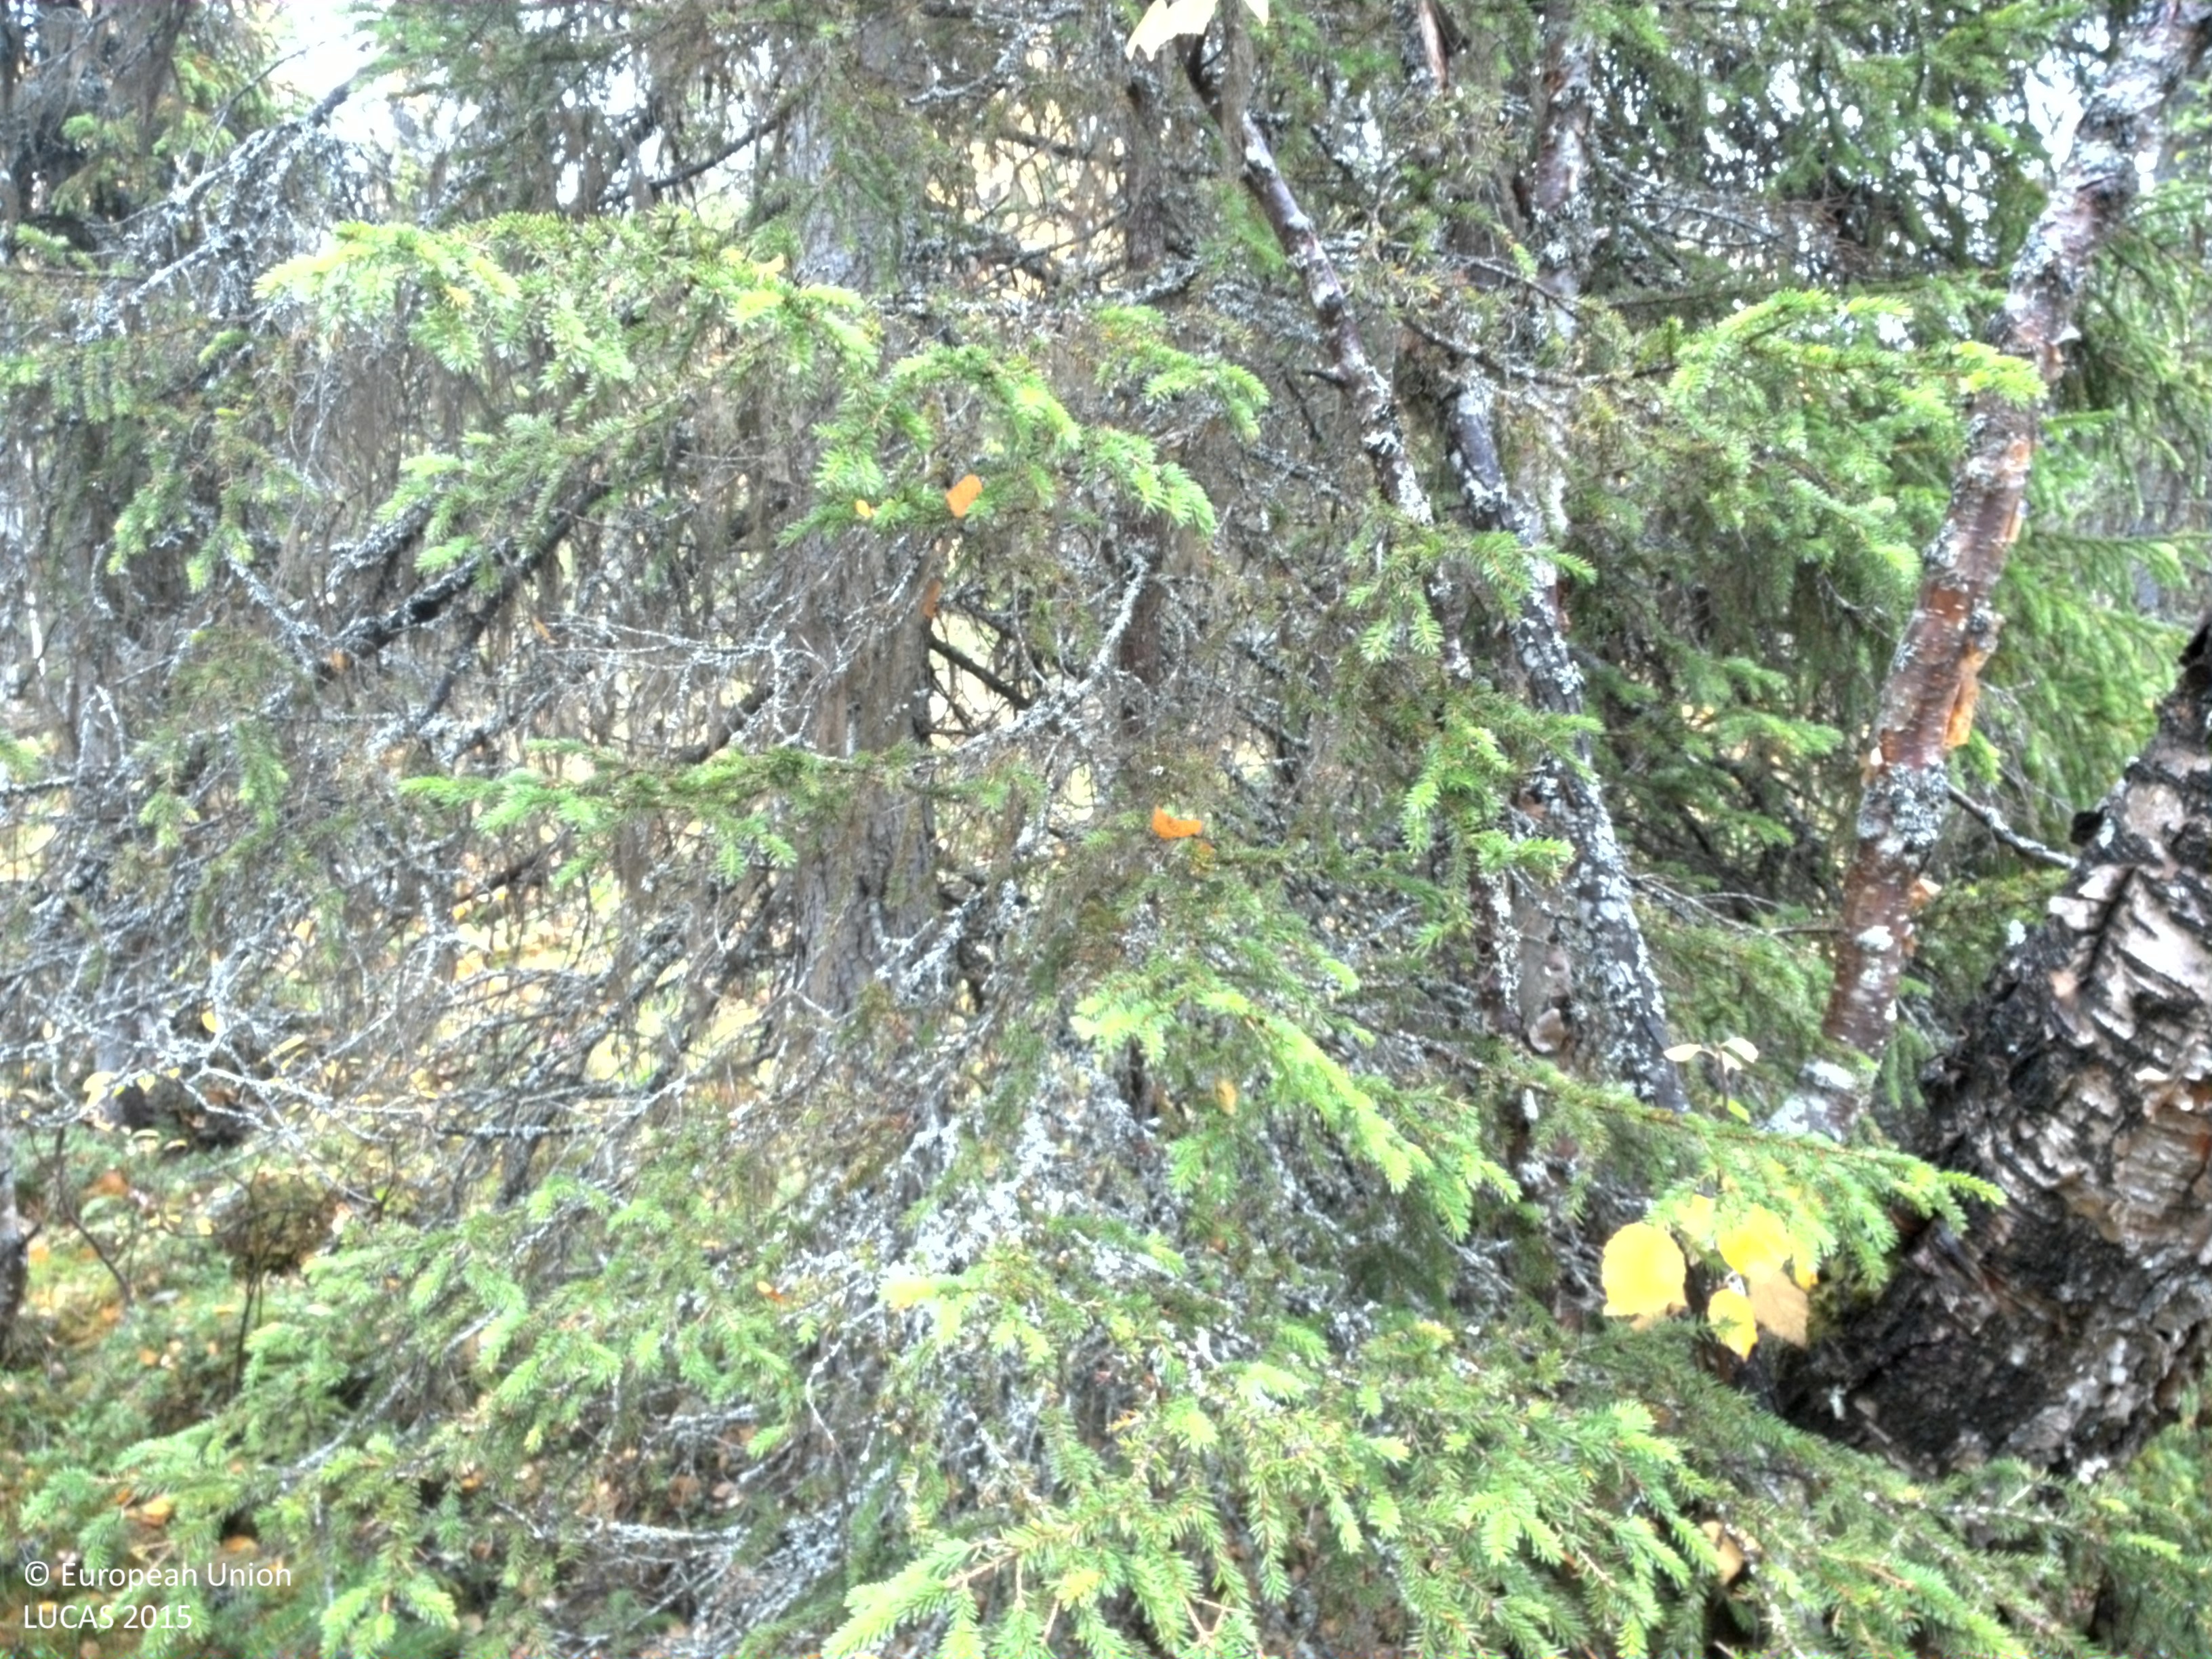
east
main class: Woodland
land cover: Spruce dominated mixed woodland
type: boreal forest
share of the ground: 25 - 50 %
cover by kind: coniferous forest trees 30 %, shrubs 20 %, herbaceous plants 20 %, lichens and mosses 20 %, broadleaved forest trees 10 %
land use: Forestry
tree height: > 5 m
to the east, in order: Spruce dominated mixed woodland; Peatbogs
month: September
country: SE
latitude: 65.2544
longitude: 16.2369
